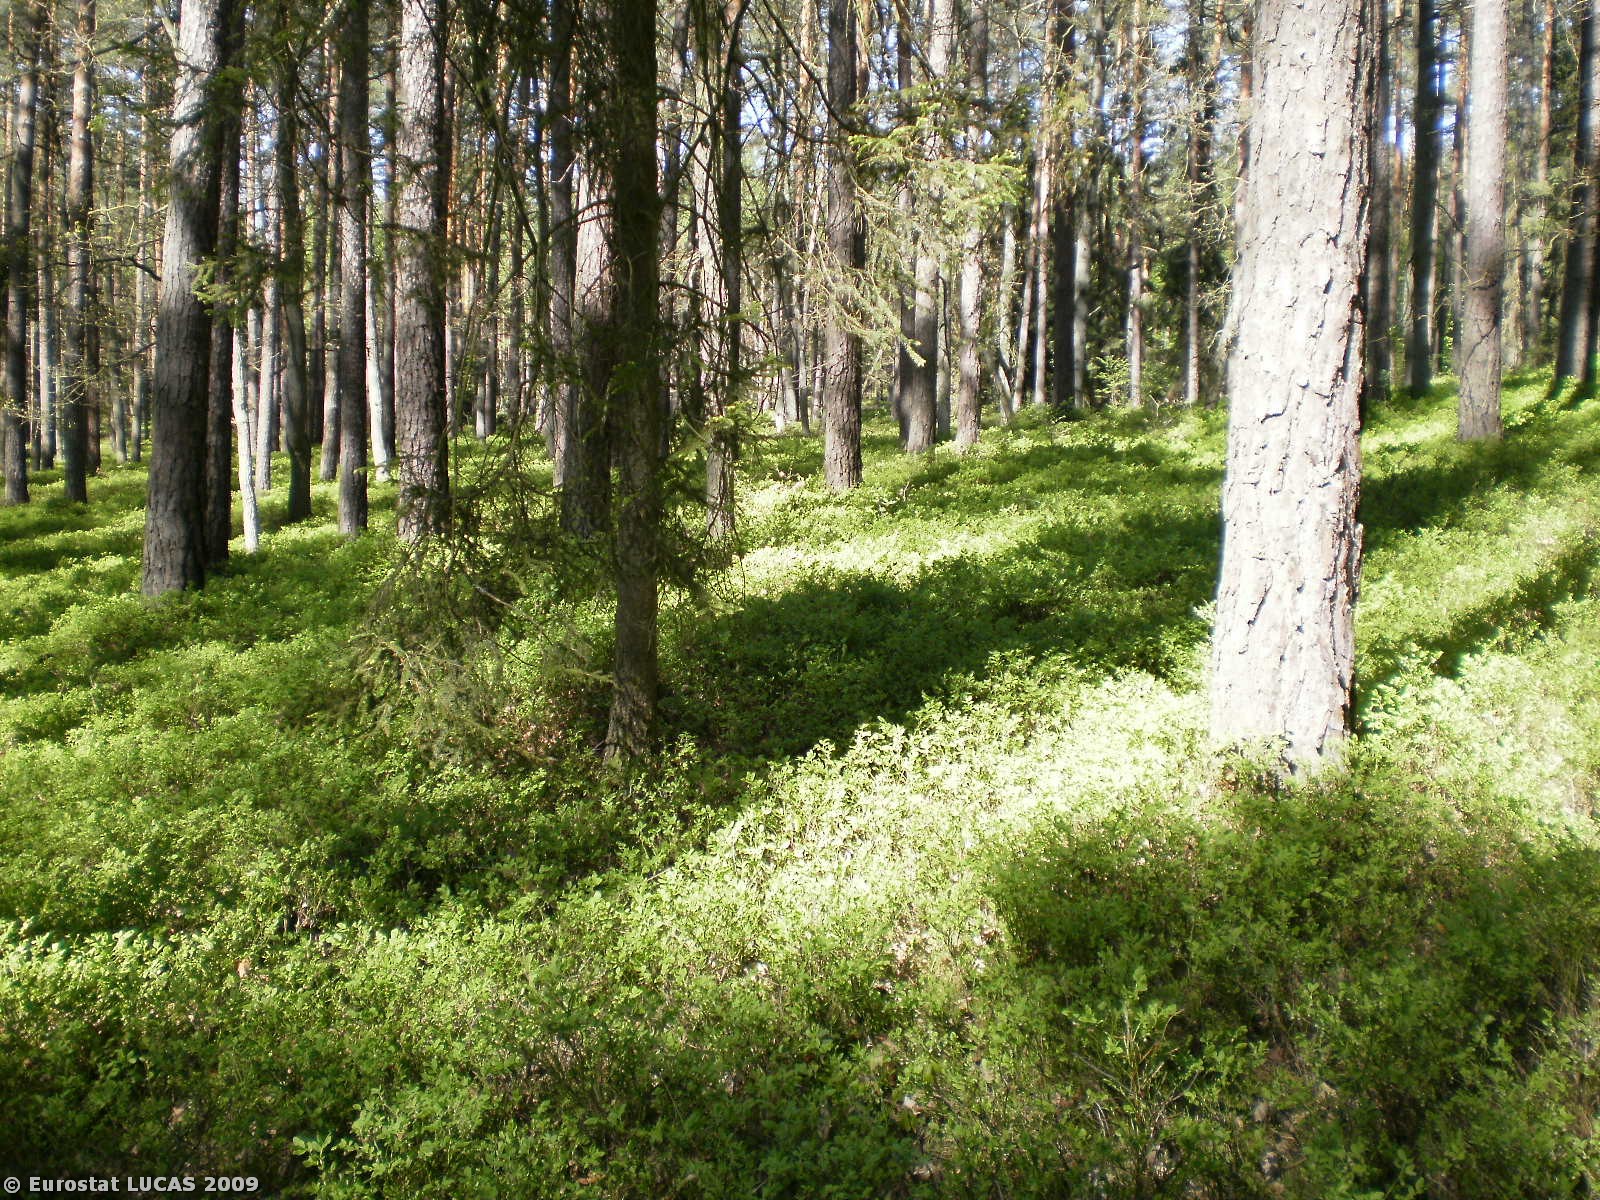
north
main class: Woodland
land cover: Coniferous woodland
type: hemiboreal forest and nemoral coniferous forest and mixed broadleaved-coniferous forest
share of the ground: > 75 %
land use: Forestry
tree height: > 5 m
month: January
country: PL
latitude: 53.9397
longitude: 18.9328
